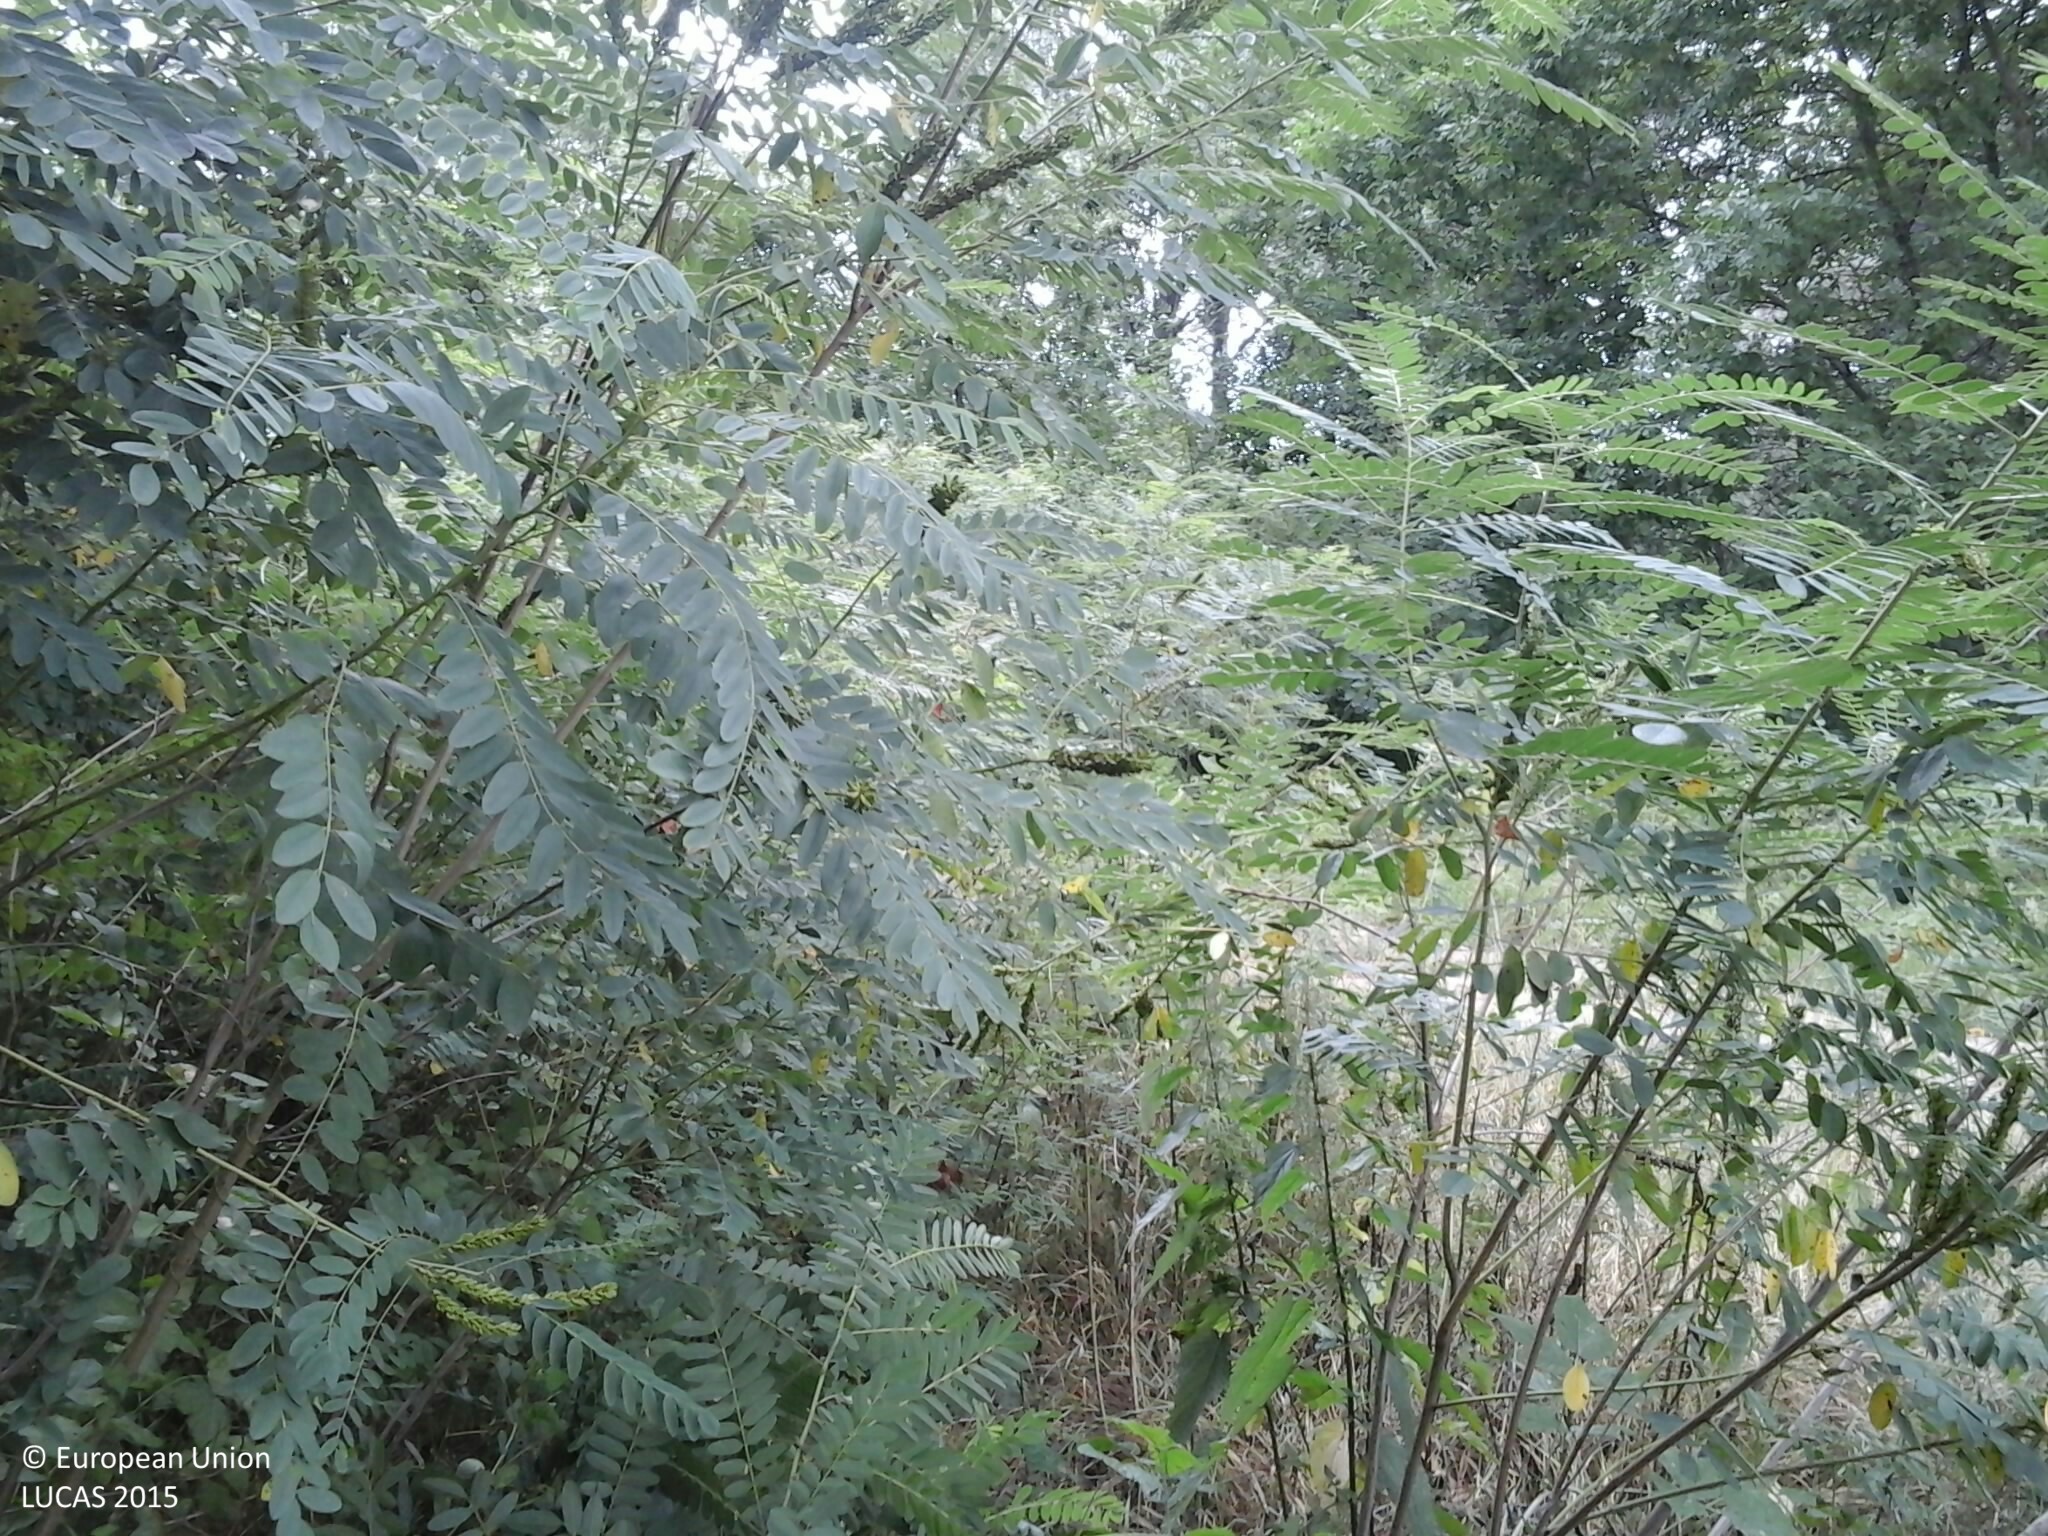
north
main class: Woodland
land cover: Broadleaved woodland
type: floodplain forest
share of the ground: 50 - 75 %
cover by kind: broadleaved forest trees 70 %, shrubs 20 %, herbaceous plants 10 %
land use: Forestry
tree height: > 5 m
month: July
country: HU
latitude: 47.8491
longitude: 21.0370
